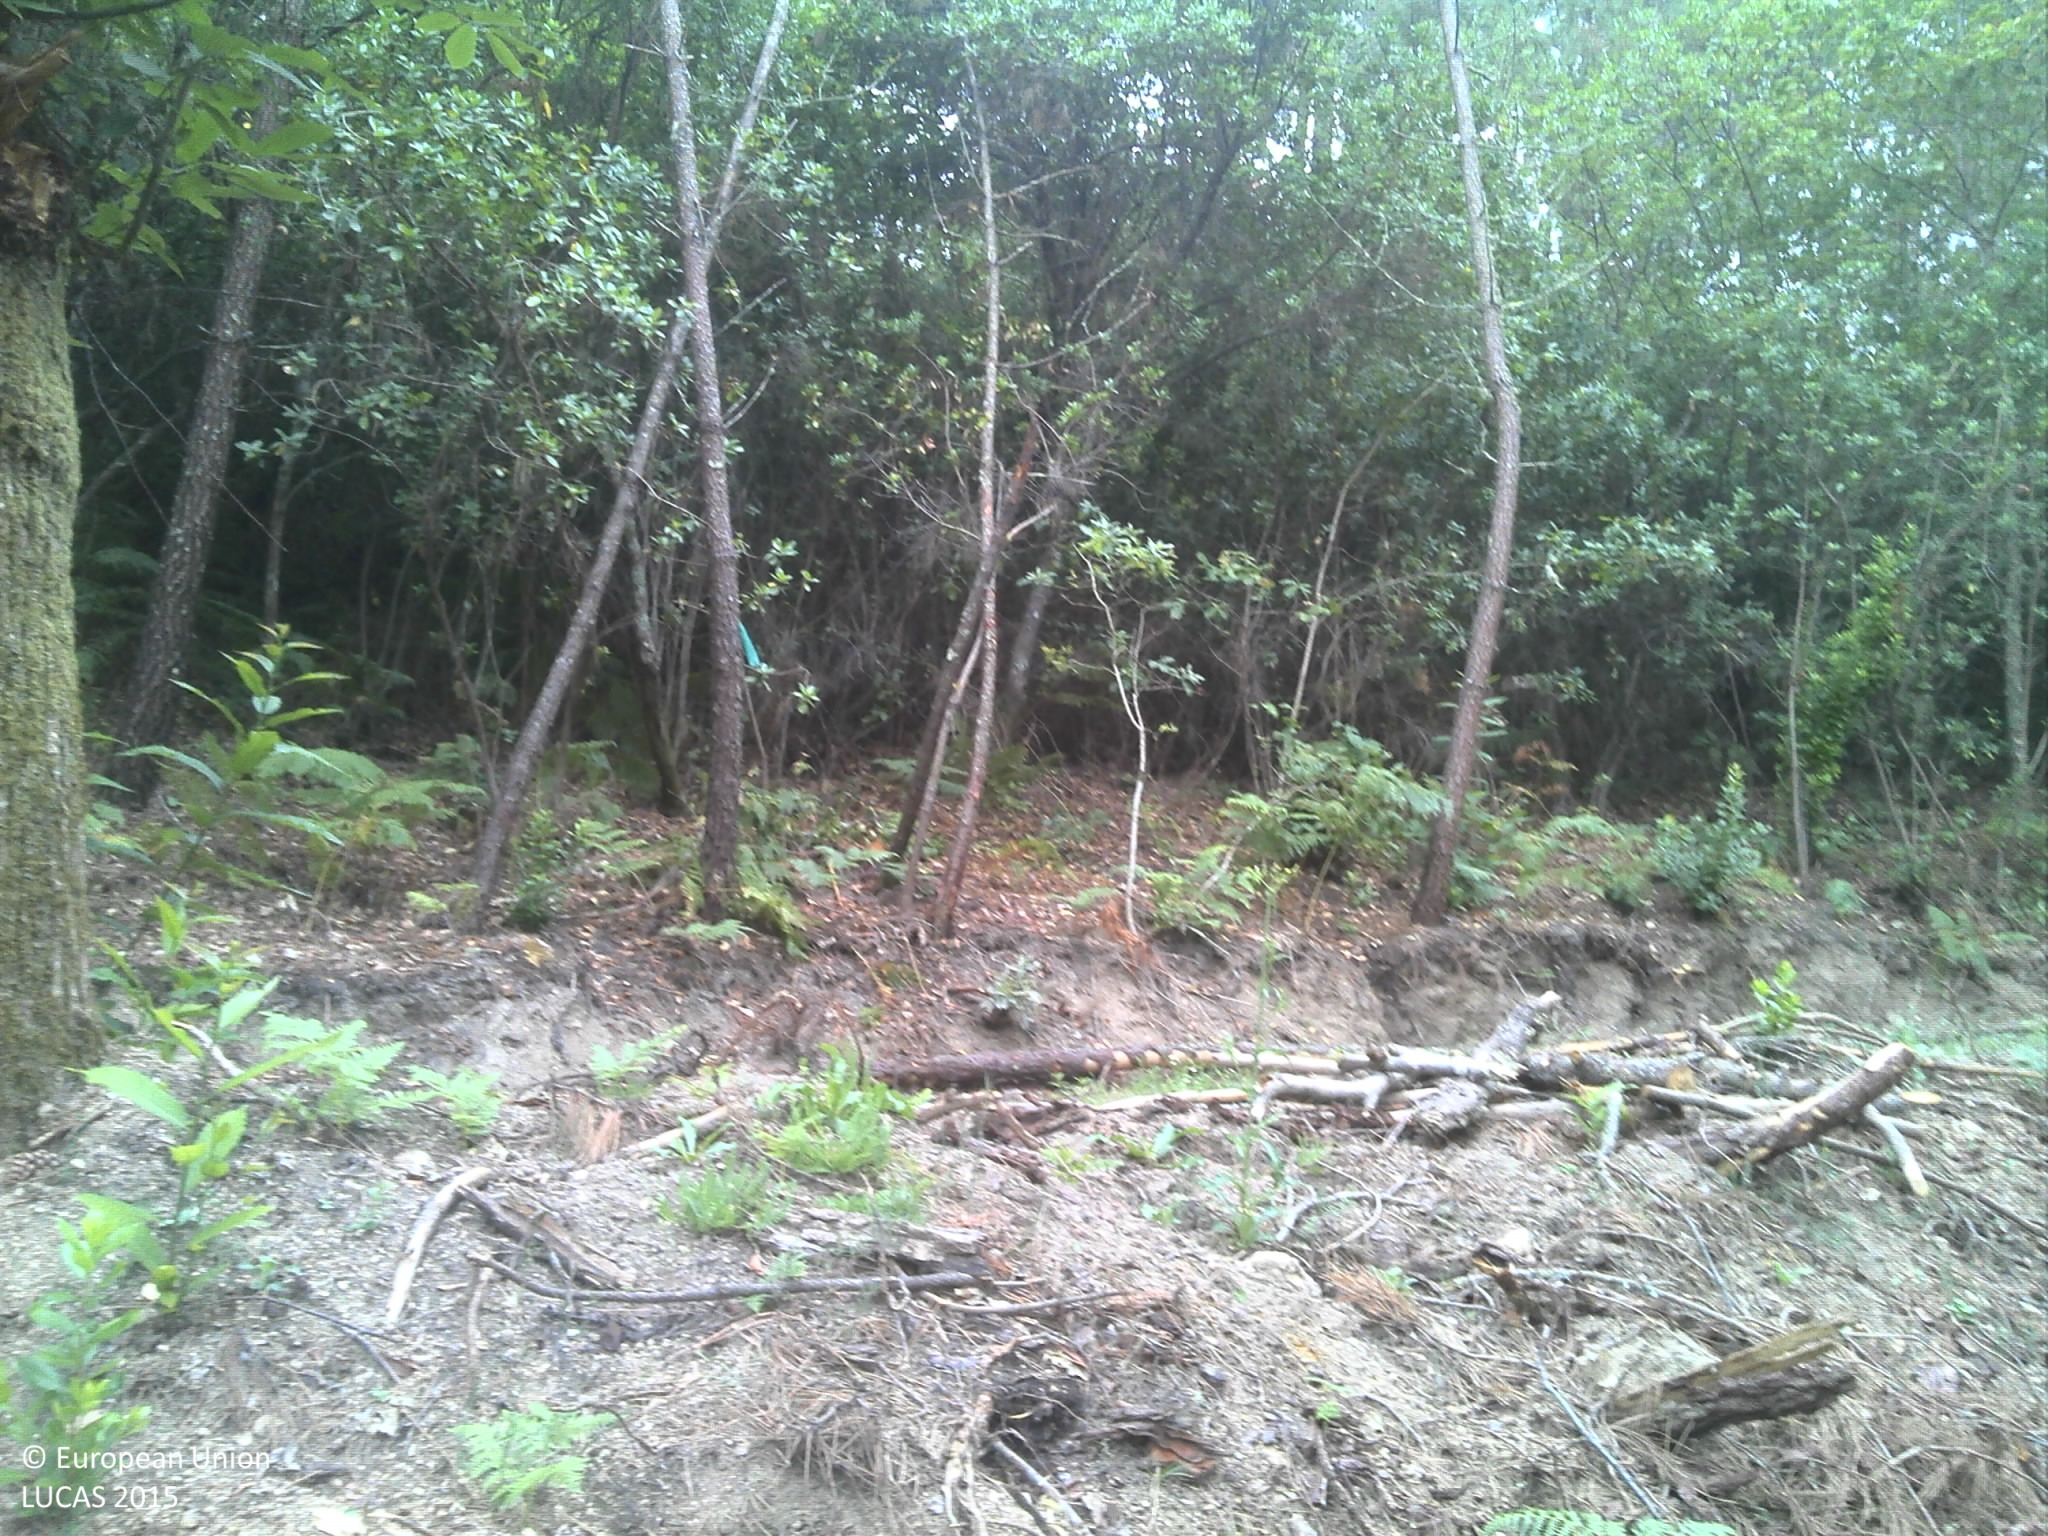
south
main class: Woodland
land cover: Broadleaved woodland
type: thermophilous deciduous forest
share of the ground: 25 - 50 %
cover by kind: broadleaved forest trees 40 %, unconsolidated bare surface 30 %, shrubs 20 %, herbaceous plants 10 %
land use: Forestry
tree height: > 5 m
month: July
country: PT
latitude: 40.3449
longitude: -7.7865
